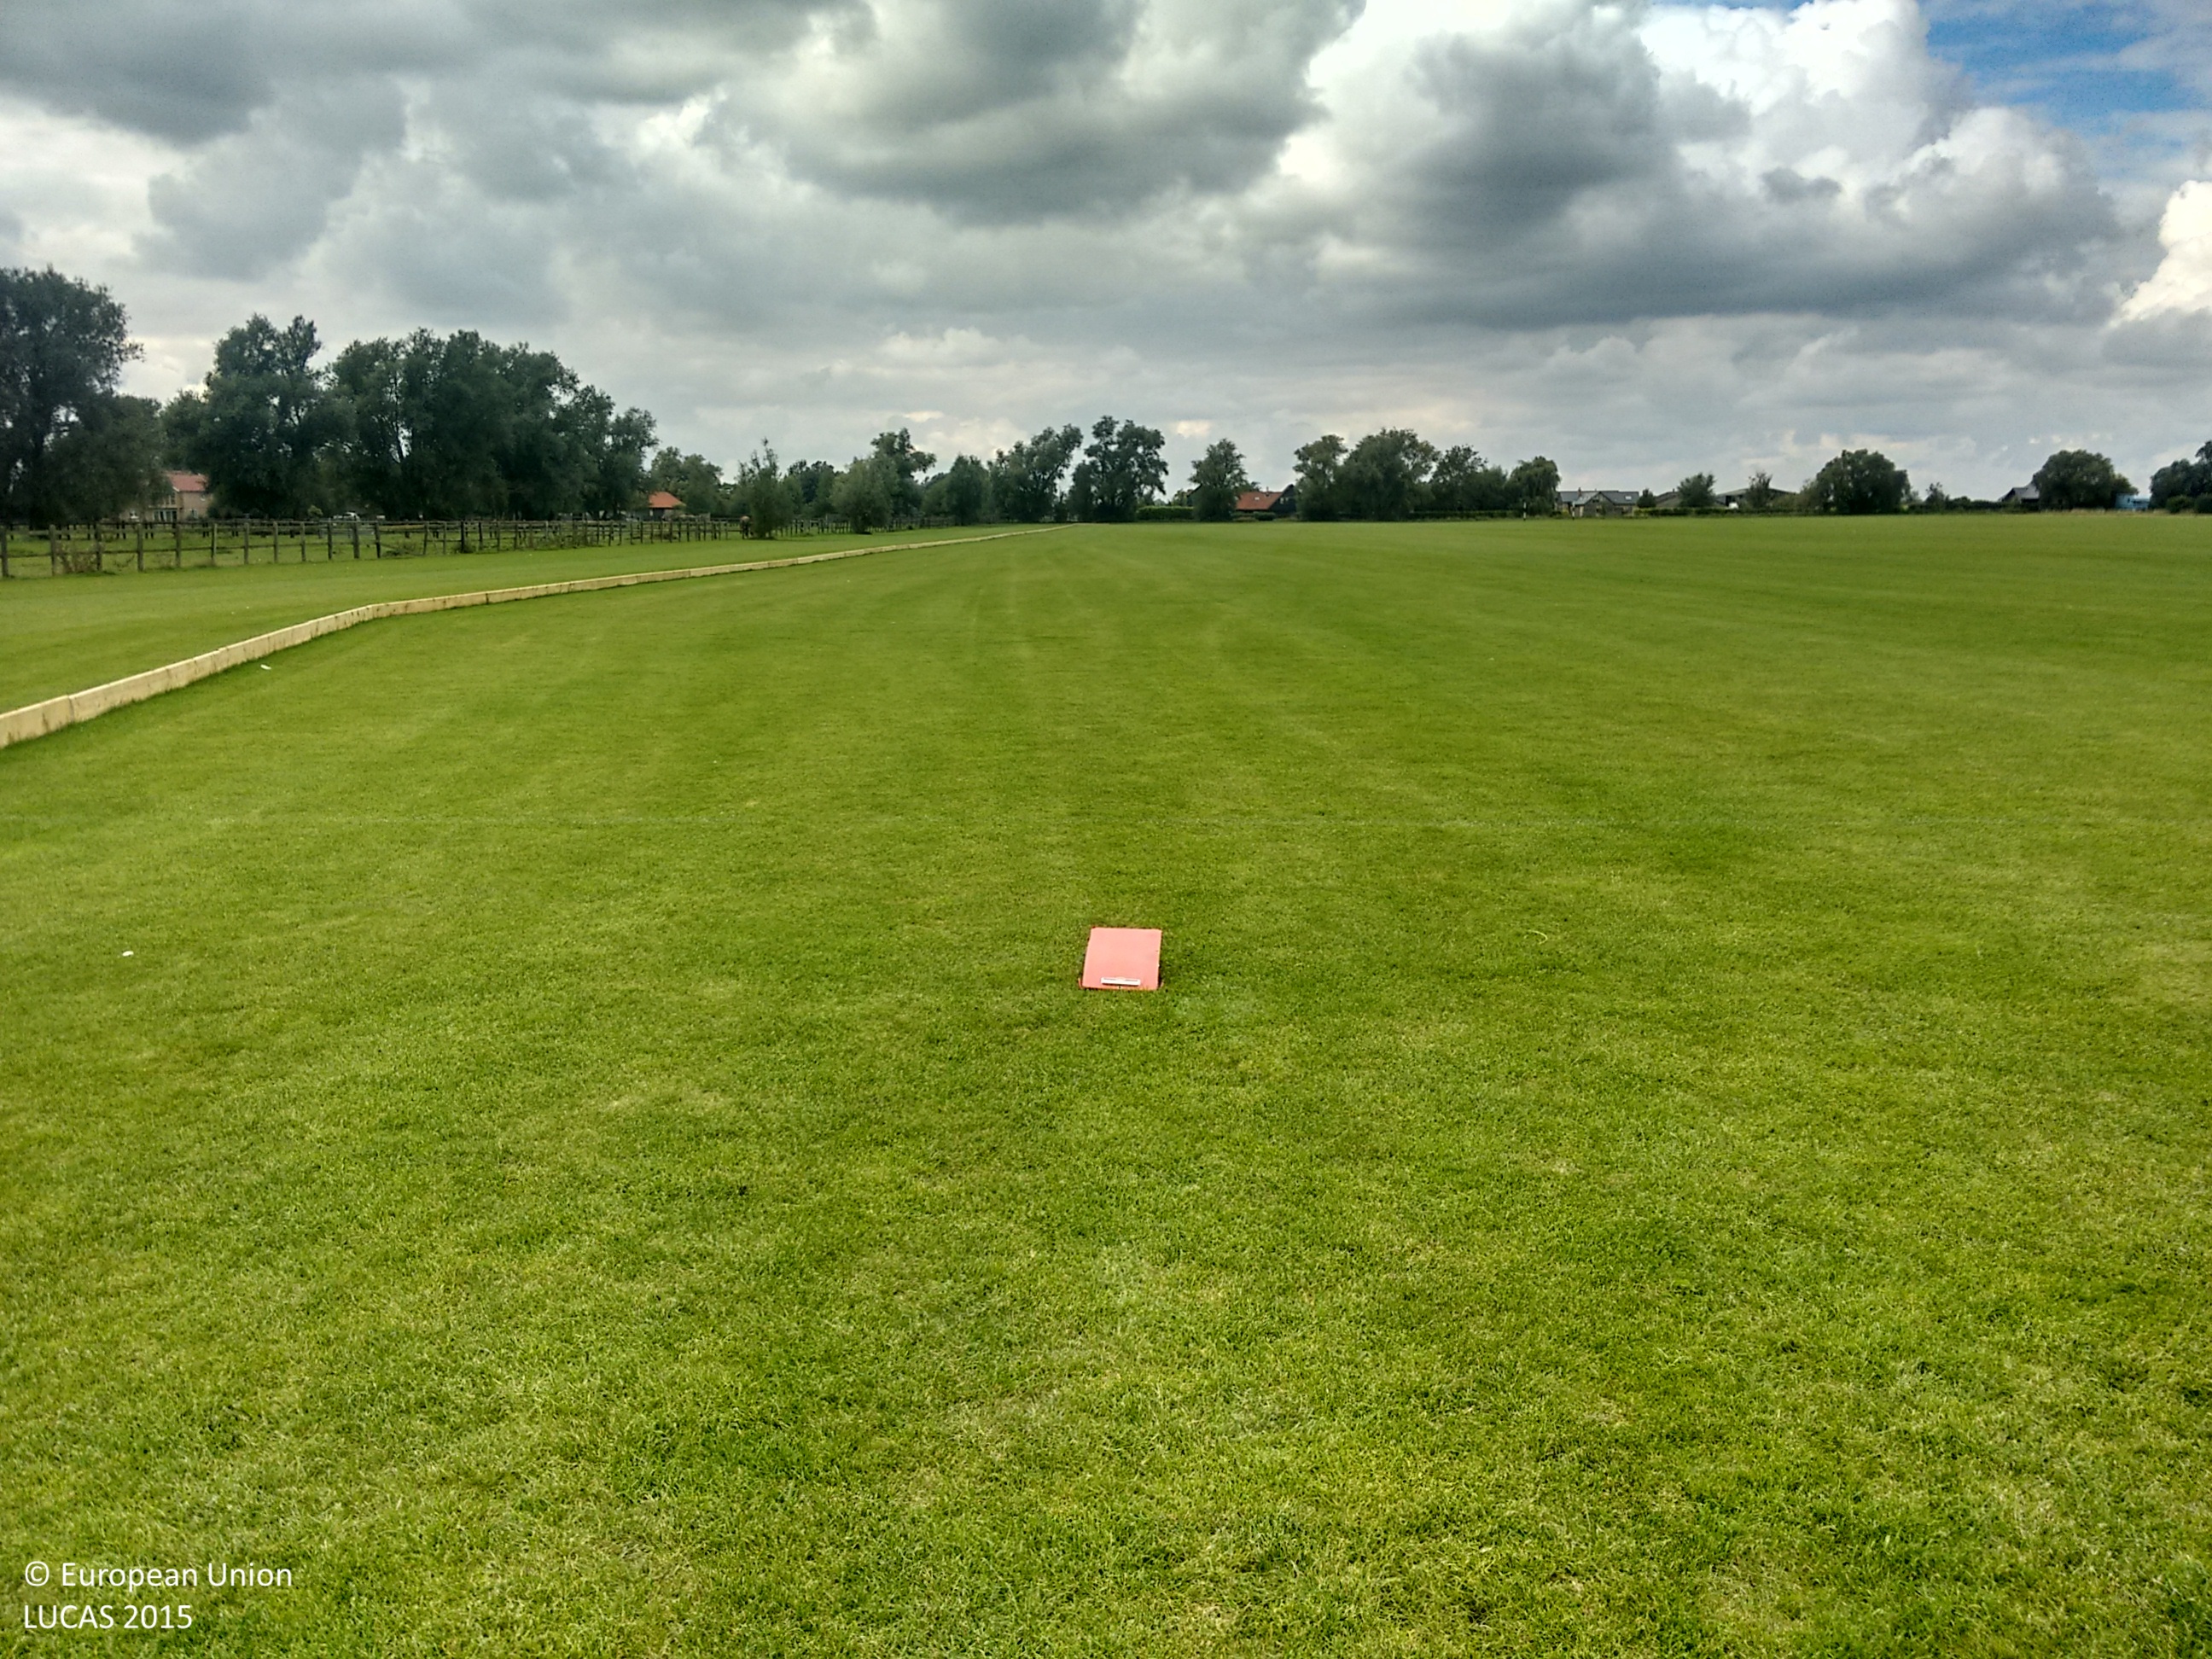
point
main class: Grassland
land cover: Grassland without tree/shrub cover
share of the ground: > 75 %
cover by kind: herbaceous plants 100 %
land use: Sport
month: September
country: GB
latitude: 52.2630
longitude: 0.2261
